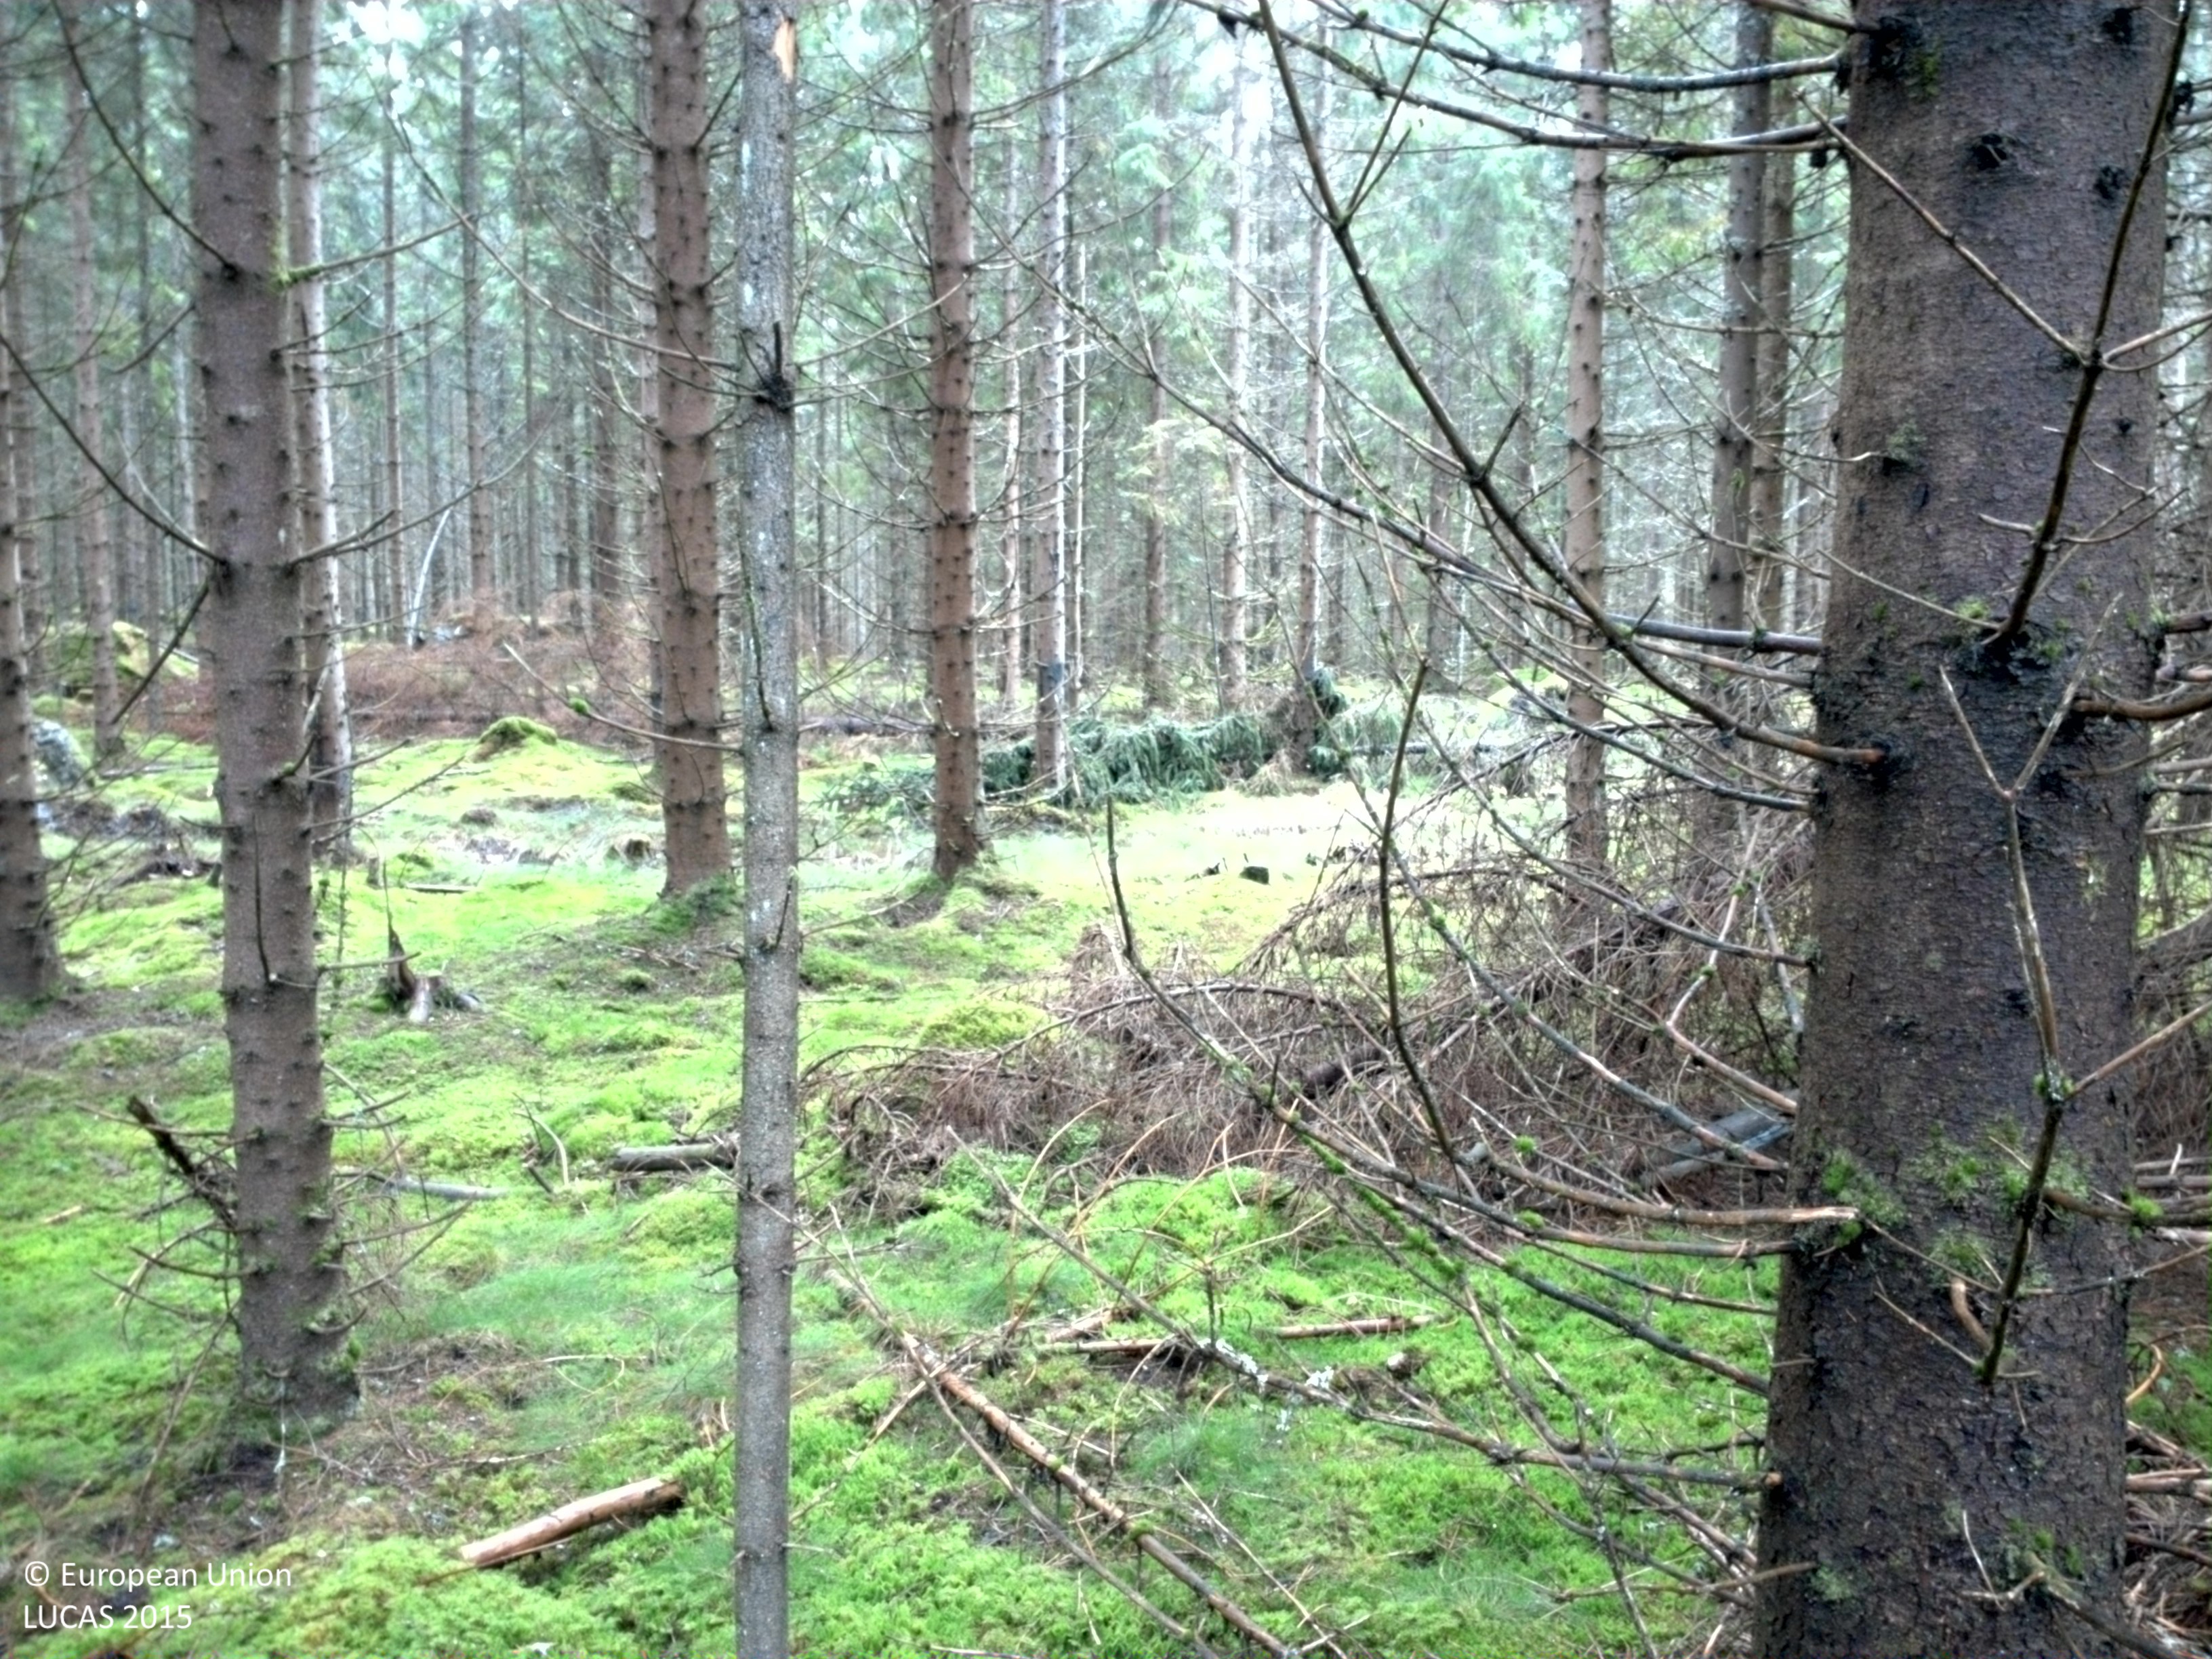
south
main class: Woodland
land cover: Spruce dominated coniferous woodland
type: boreal forest
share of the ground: 50 - 75 %
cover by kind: coniferous forest trees 60 %, lichens and mosses 30 %, herbaceous plants 10 %
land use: Forestry
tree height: > 5 m
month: September
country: SE
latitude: 58.1289
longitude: 13.1362
